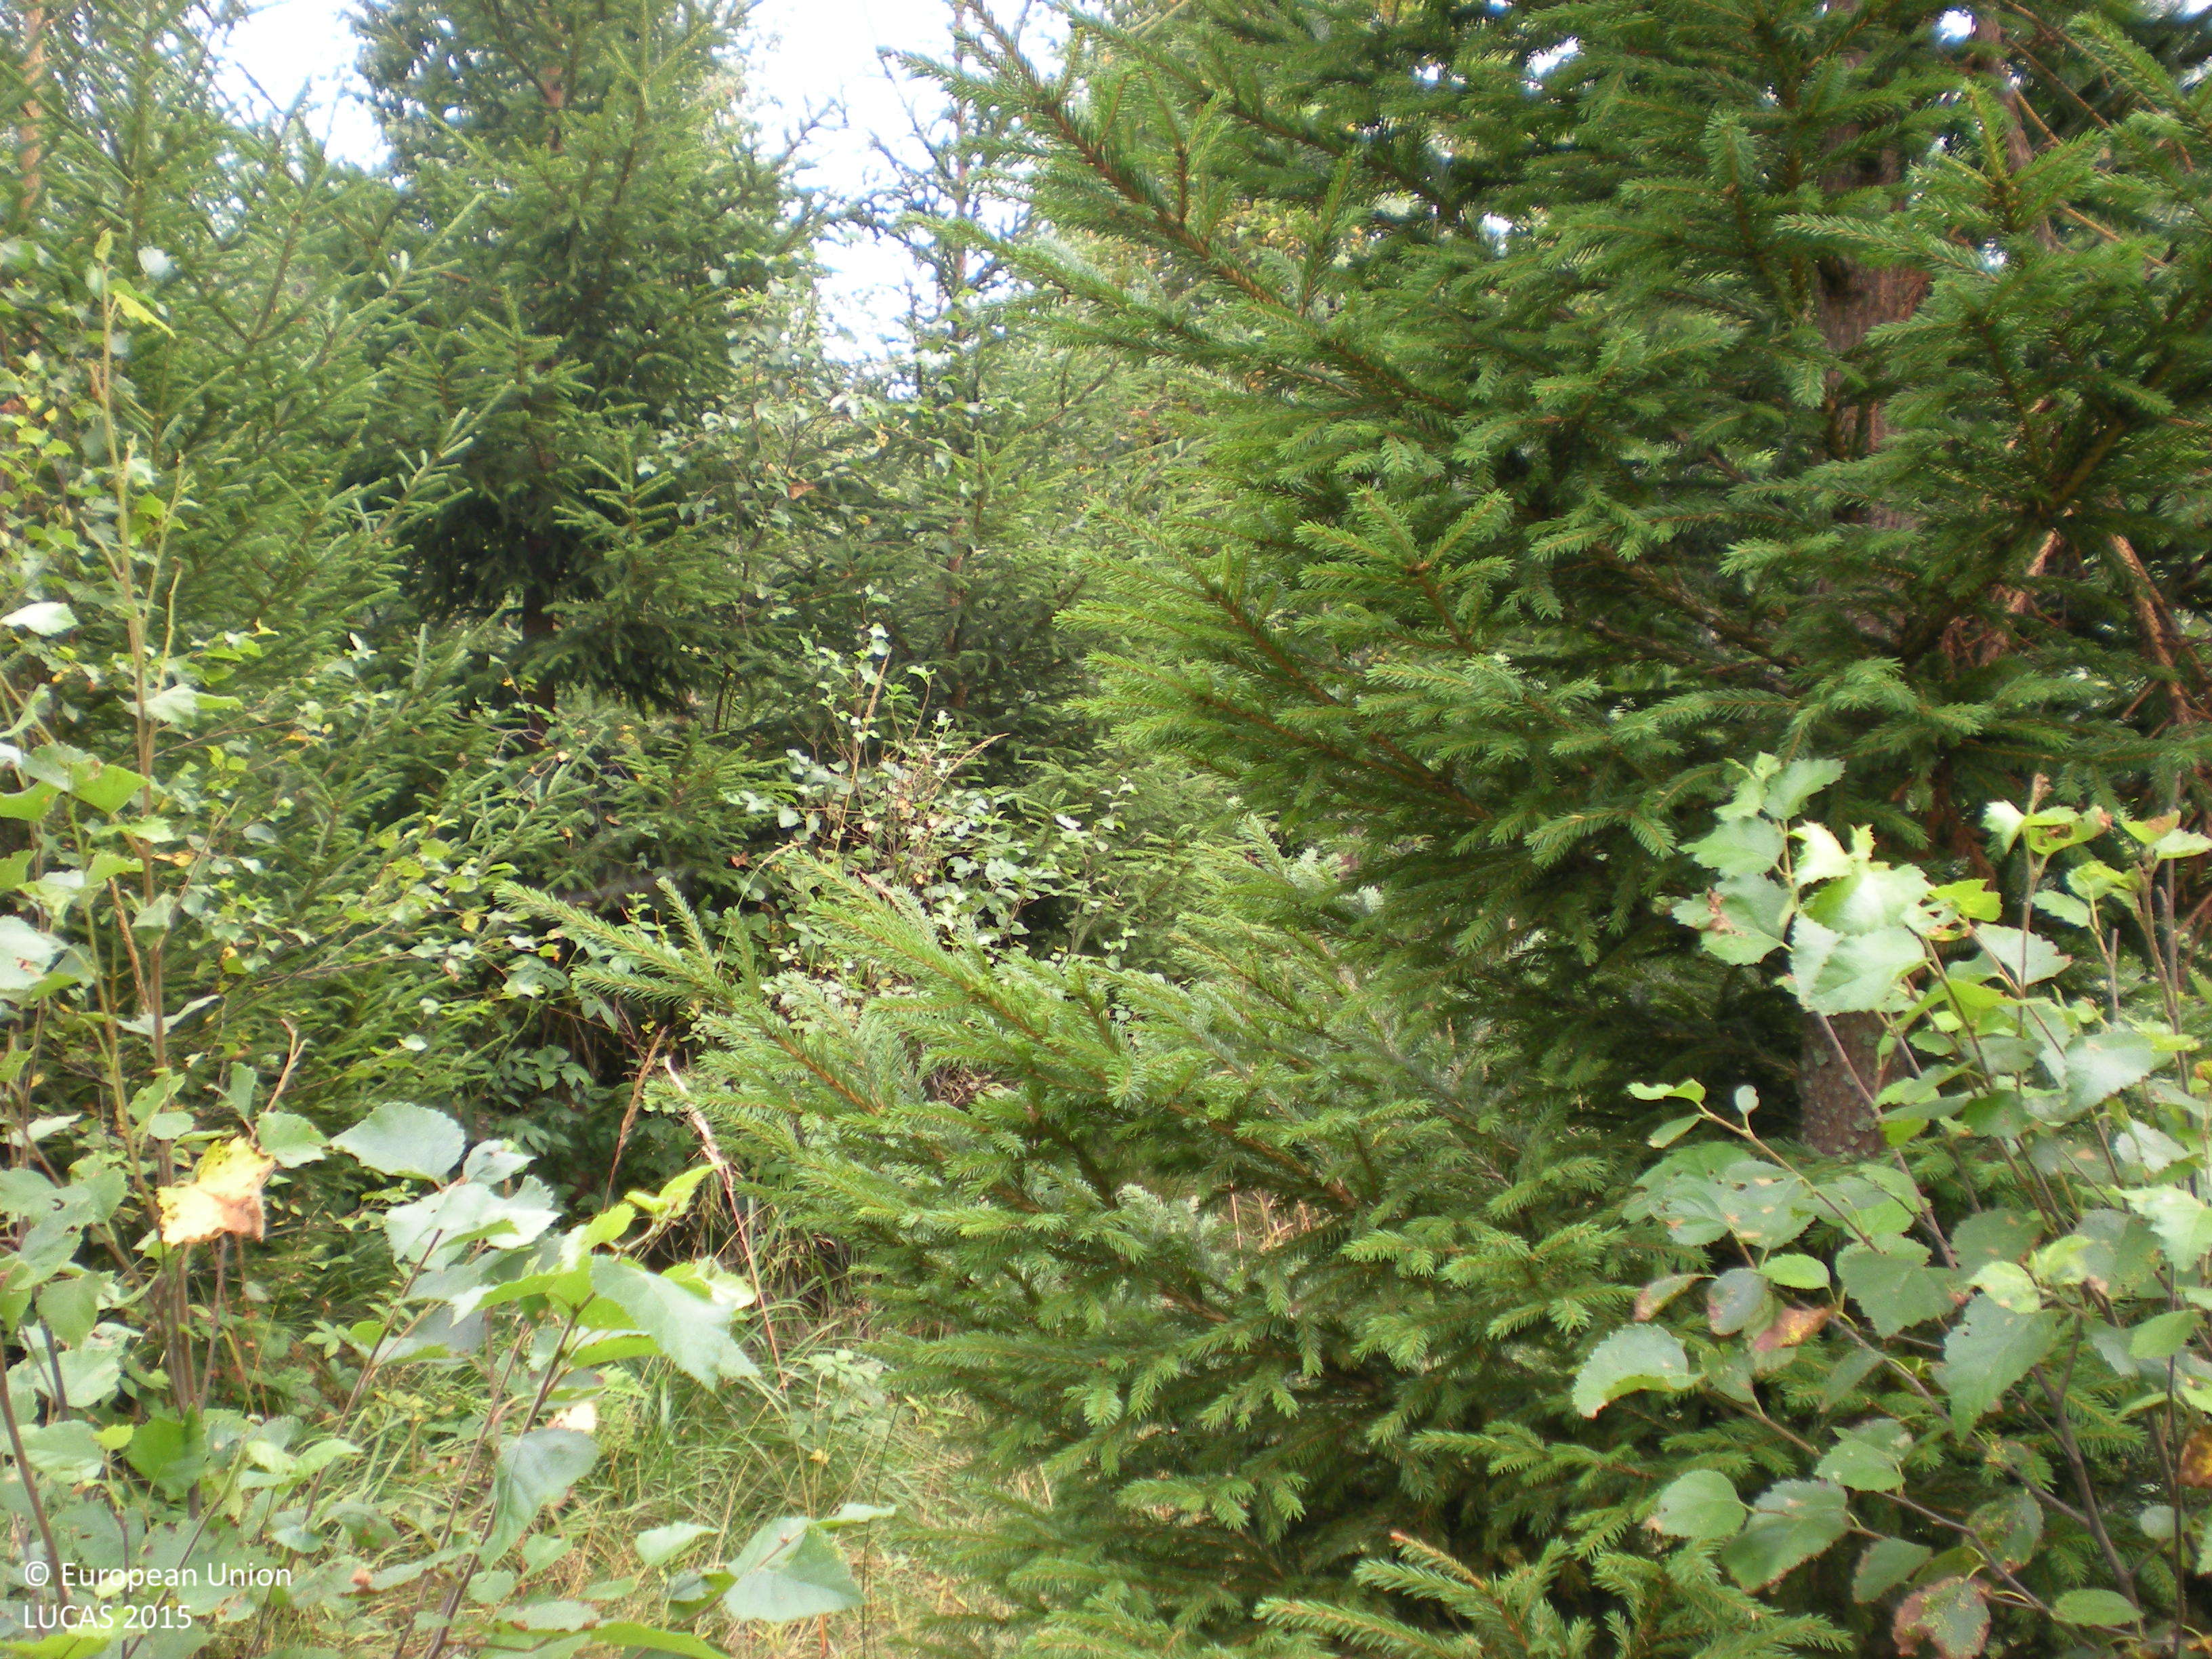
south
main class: Woodland
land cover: Spruce dominated mixed woodland
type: boreal forest
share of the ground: > 75 %
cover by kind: broadleaved forest trees 50 %, coniferous forest trees 40 %, herbaceous plants 10 %
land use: Forestry
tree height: < 5 m
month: August
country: SE
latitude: 60.5095
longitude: 17.0737
